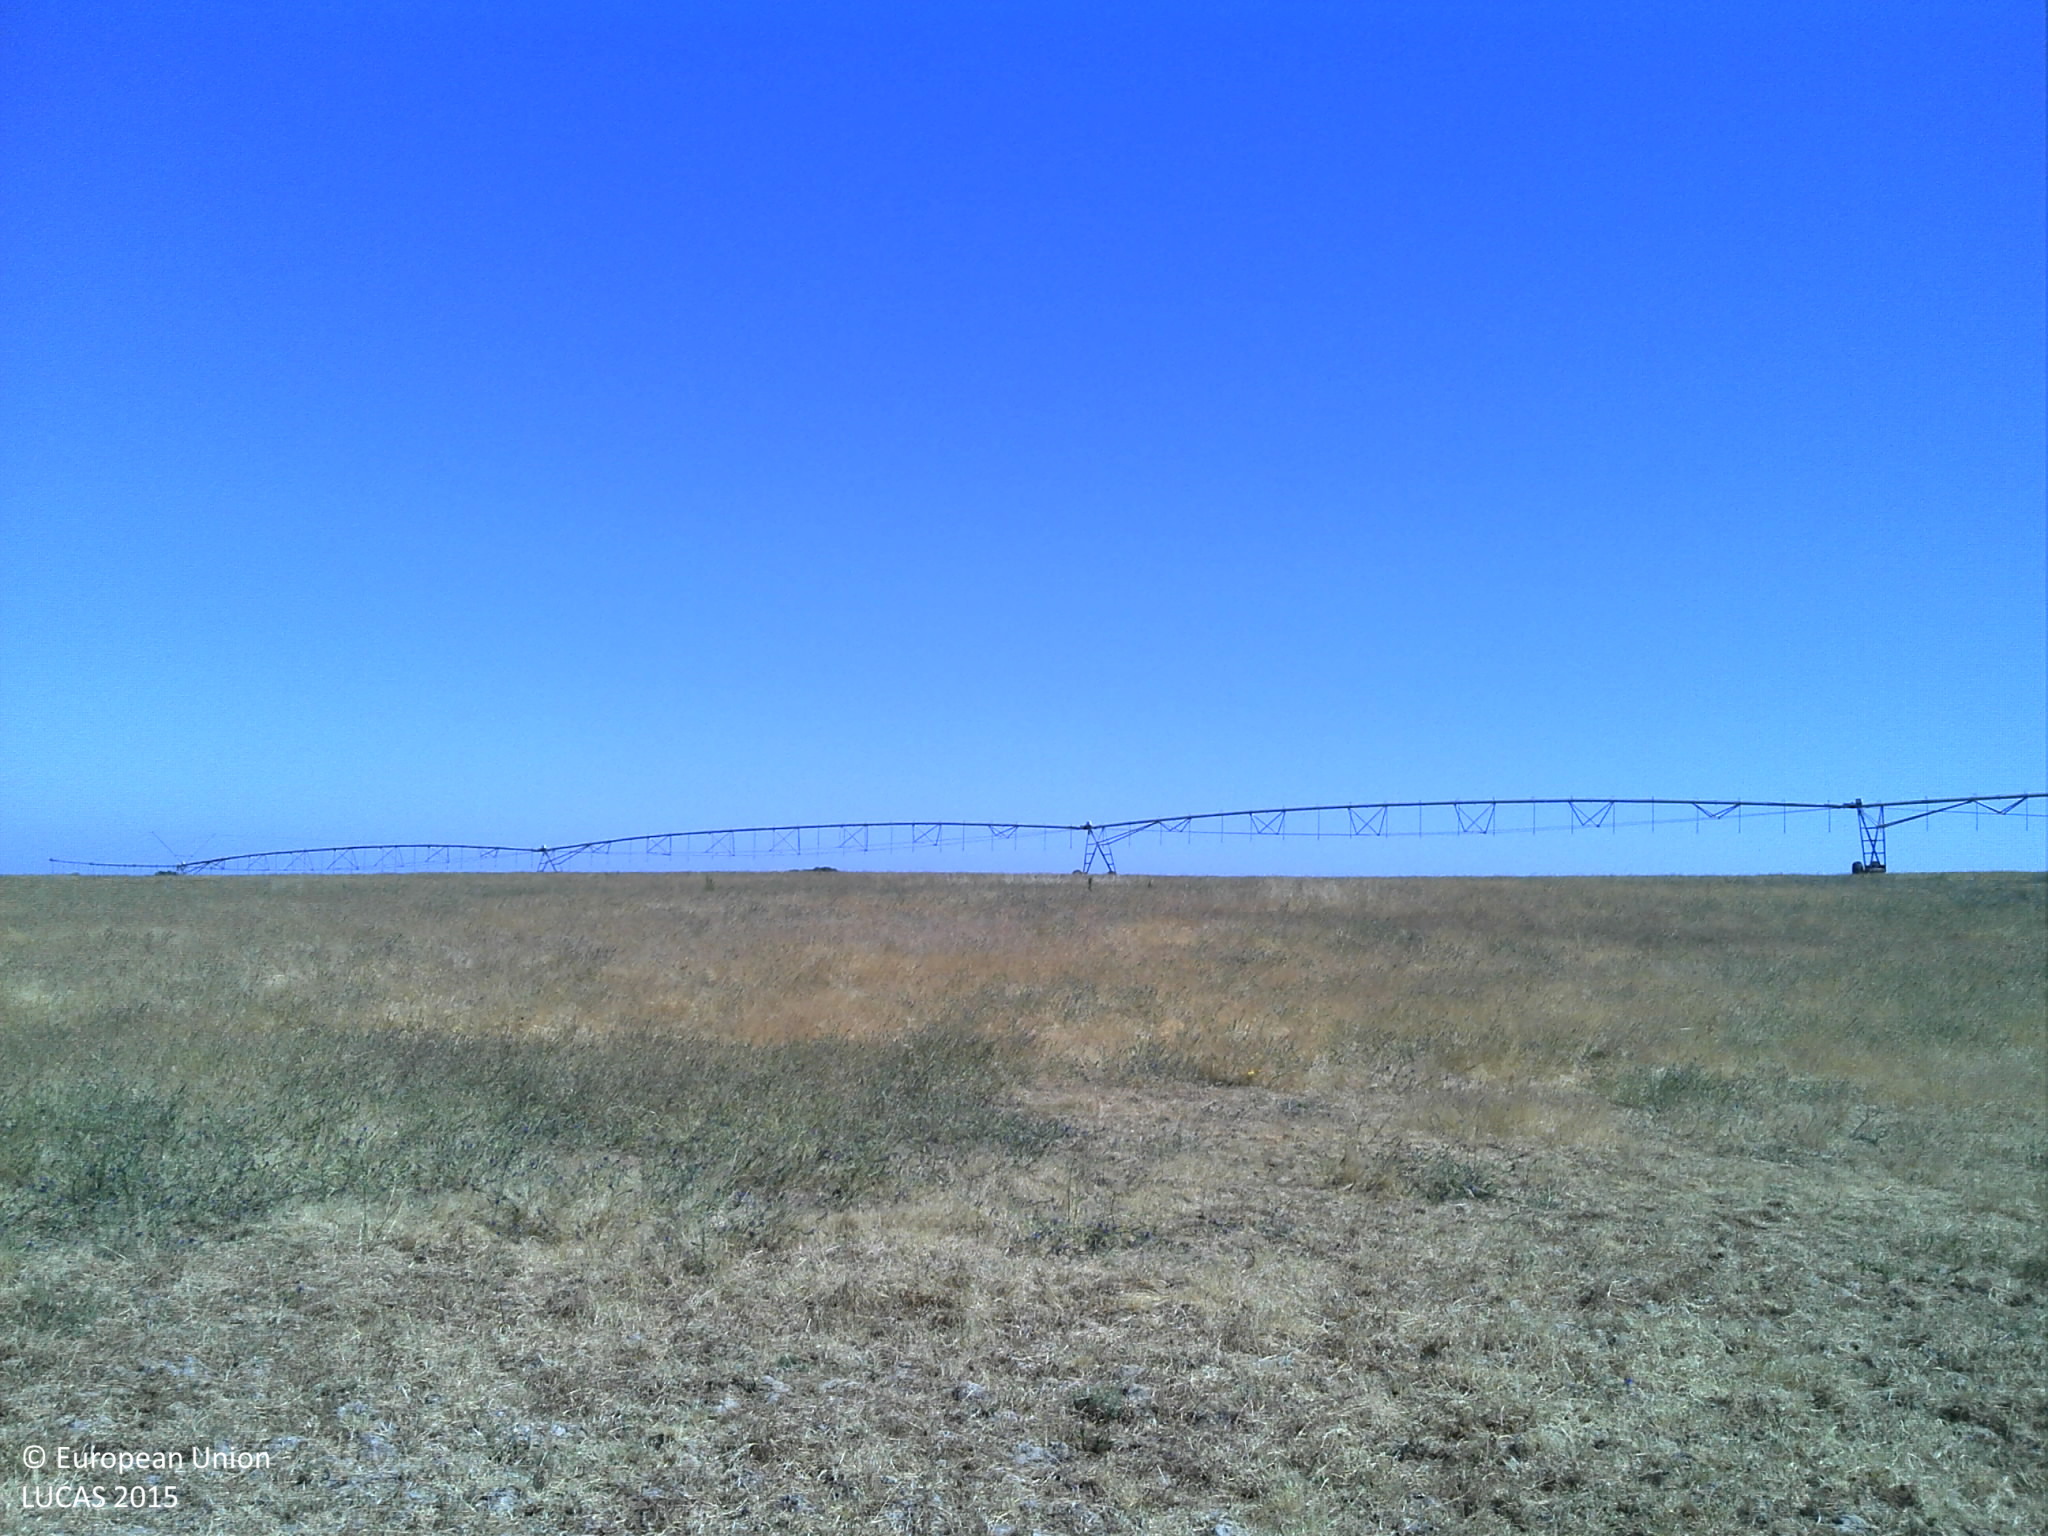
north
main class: Grassland
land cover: Spontaneously vegetated surfaces
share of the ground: > 75 %
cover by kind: herbaceous plants 75 %, unconsolidated bare surface 25 %
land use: Agriculture (excluding fallow land and kitchen gardens)
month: June
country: PT
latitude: 38.7486
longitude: -8.2187
